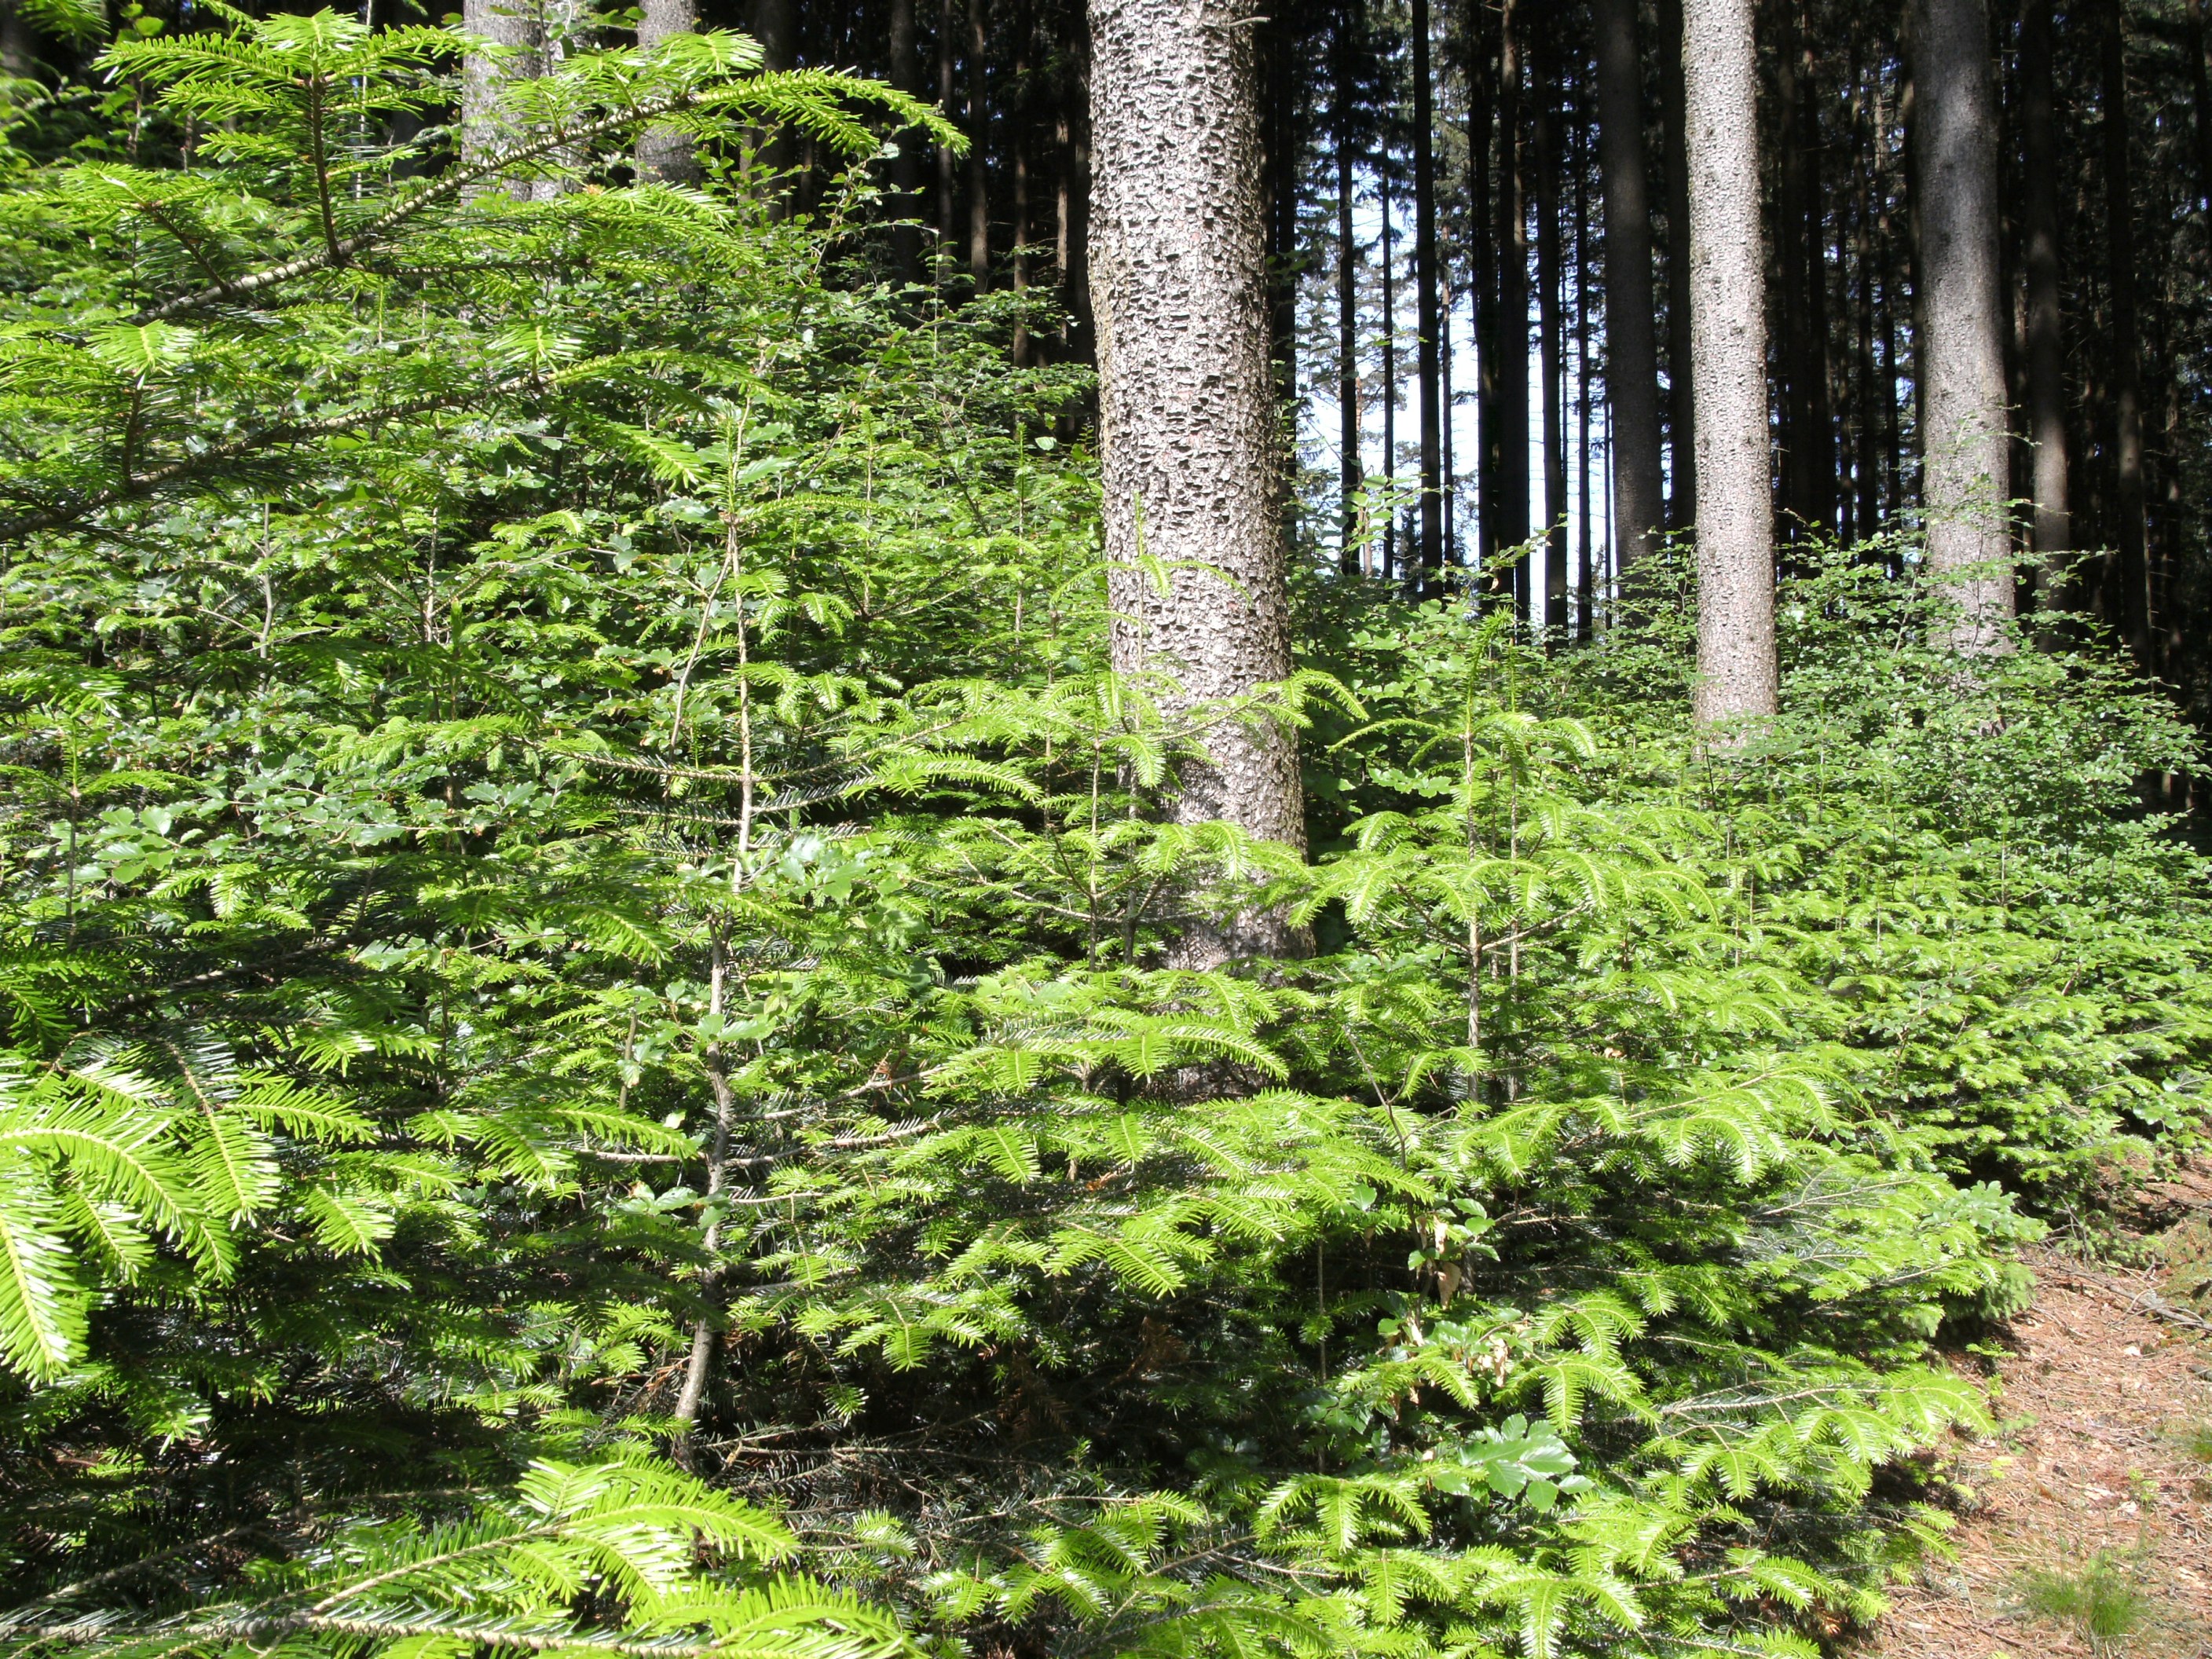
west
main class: Woodland
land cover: Other mixed woodland
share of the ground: > 75 %
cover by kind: coniferous forest trees 55 %, broadleaved forest trees 35 %, herbaceous plants 10 %
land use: Forestry
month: June
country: AT
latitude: 48.1112
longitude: 13.5854
